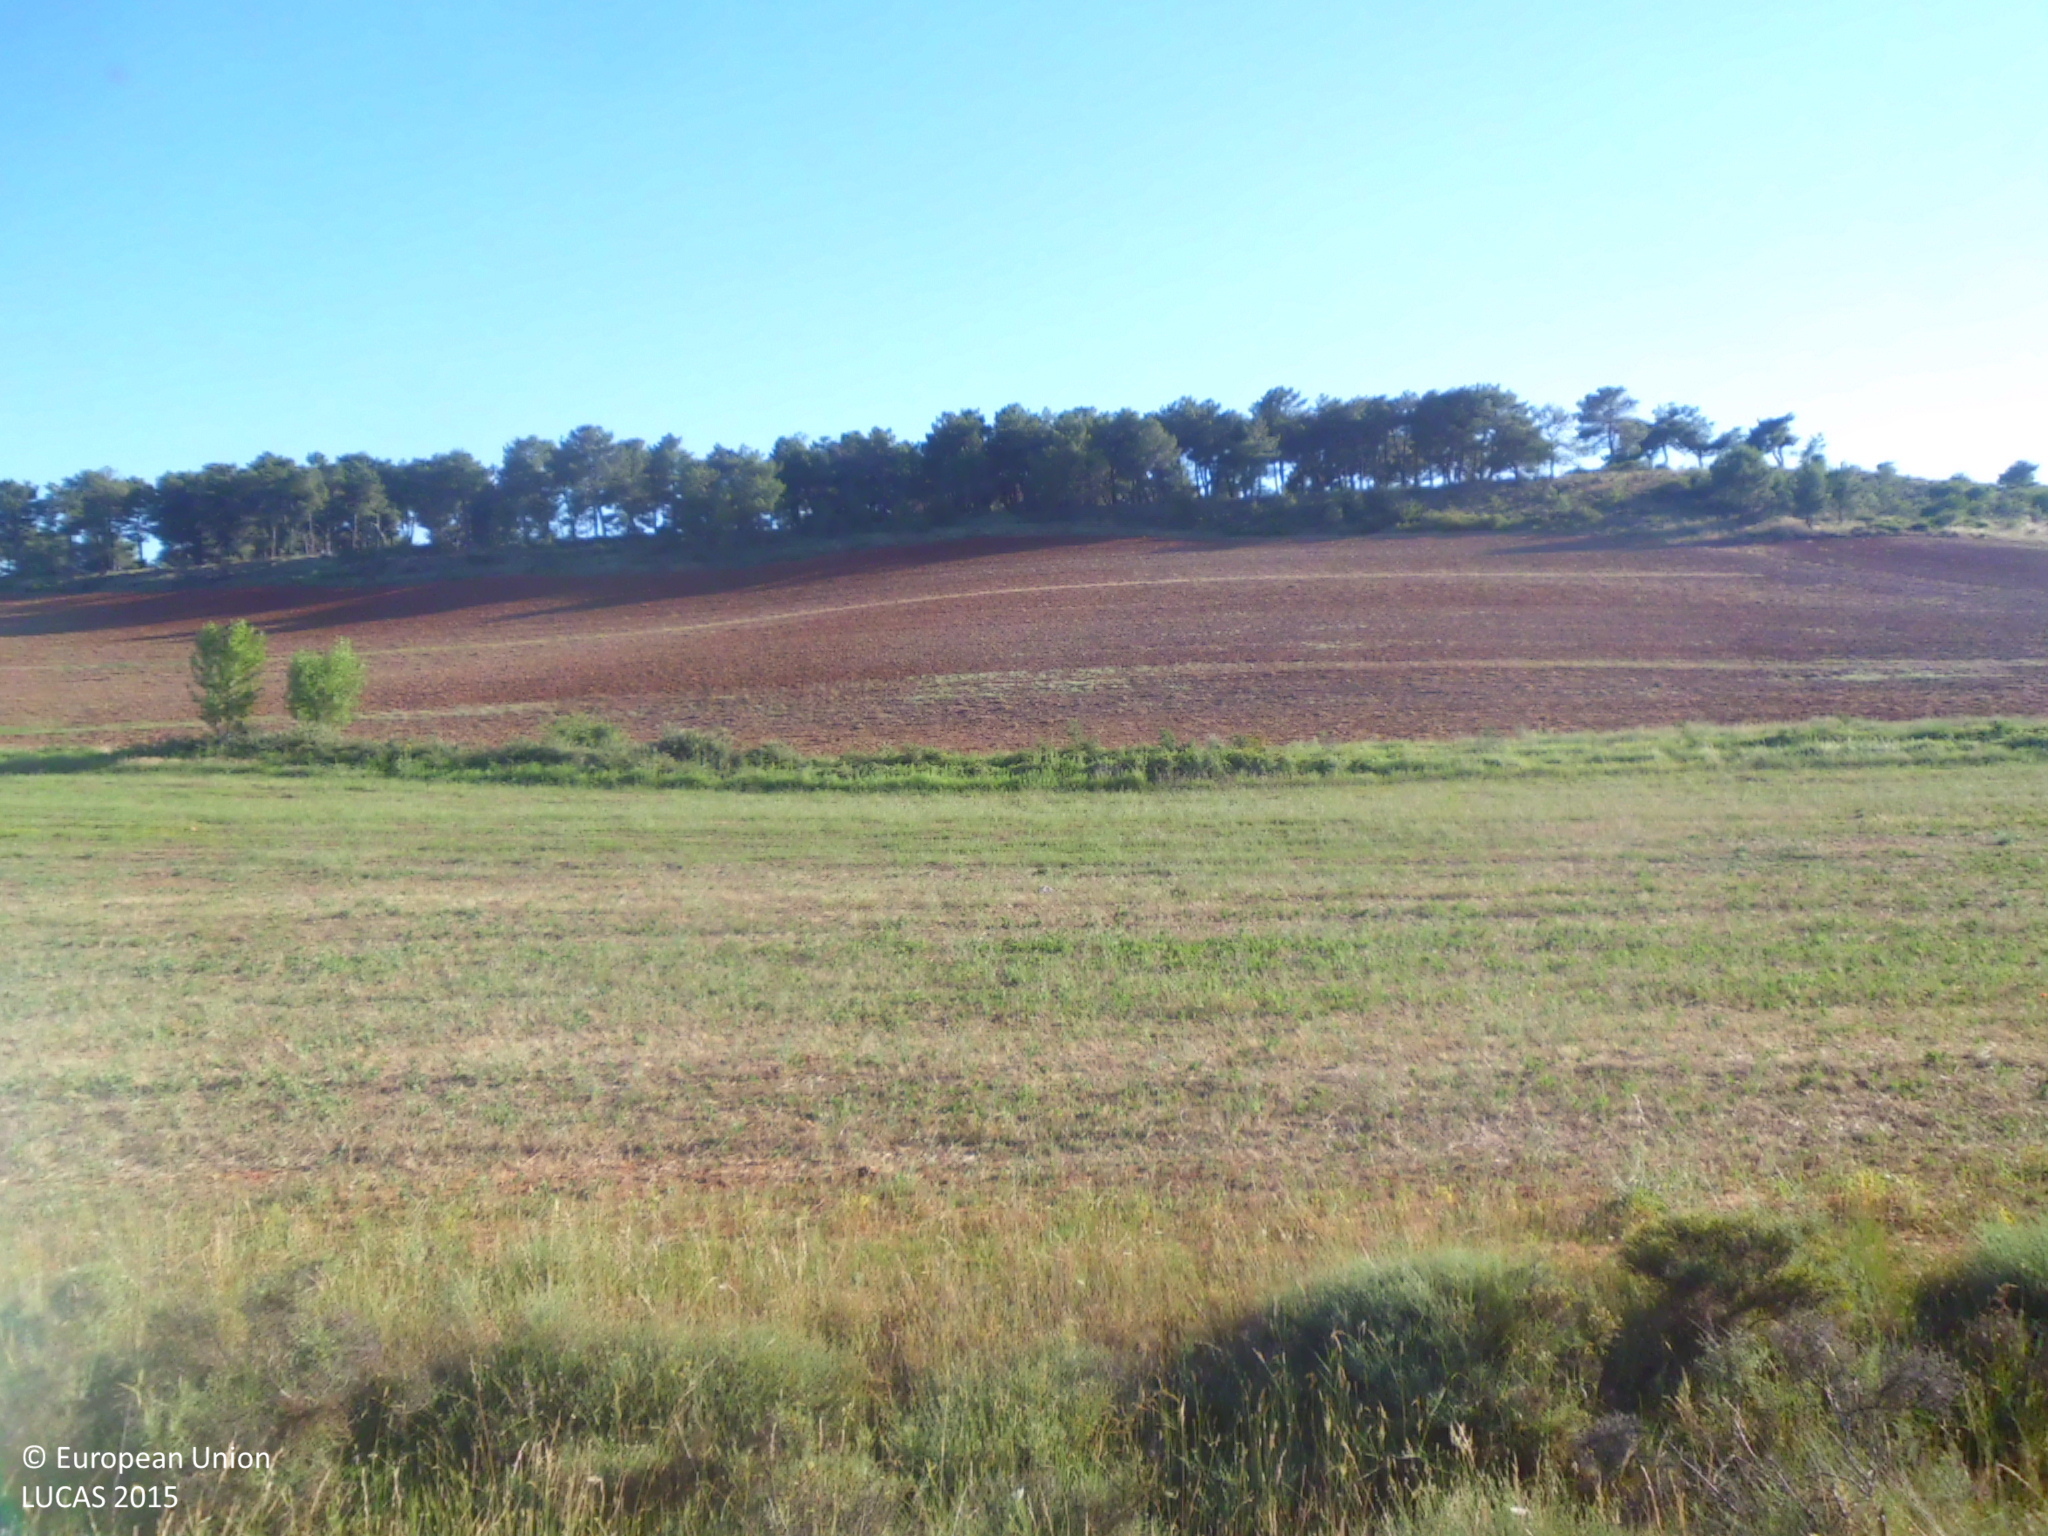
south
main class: Shrubland
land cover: Shrubland without tree cover
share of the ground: 50 - 75 %
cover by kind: shrubs 60 %, herbaceous plants 30 %, consolidated bare surface 10 %
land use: Semi-natural and natural areas not in use
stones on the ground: 25 - 50 %
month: July
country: ES
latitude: 42.6287
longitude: -4.2537
